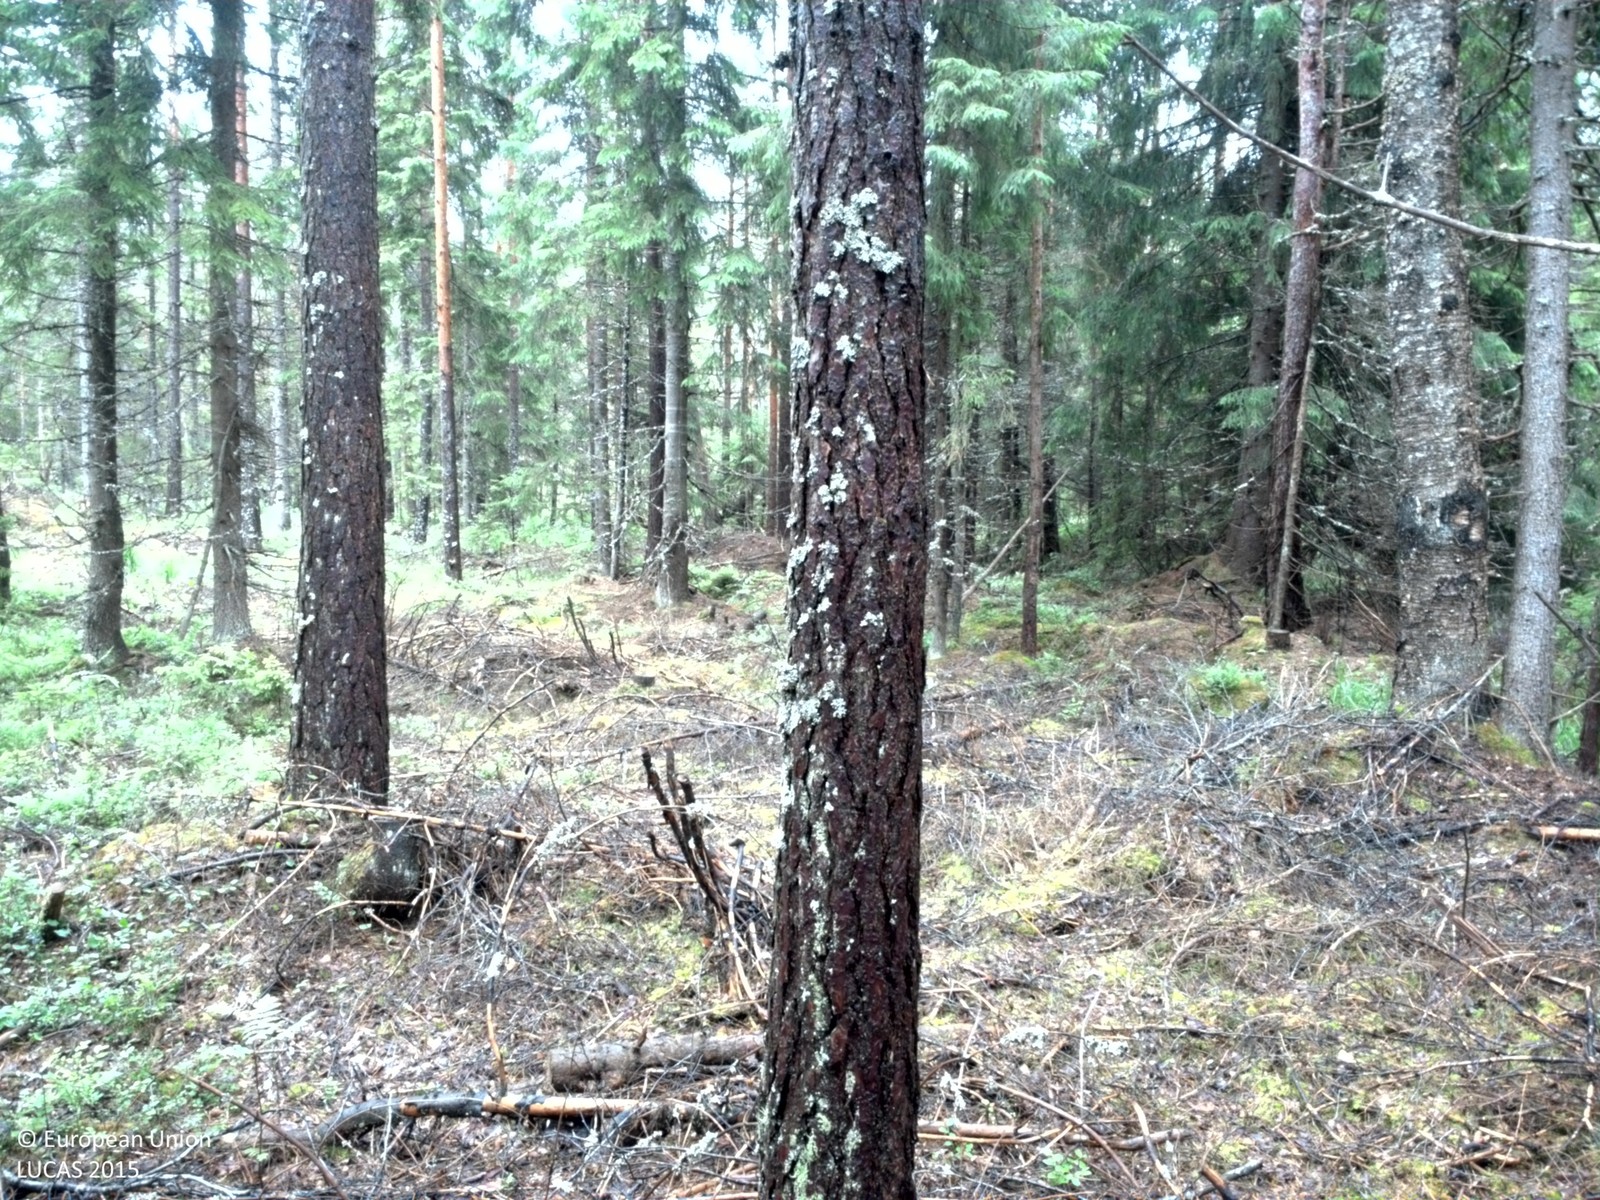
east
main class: Woodland
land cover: Spruce dominated coniferous woodland
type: boreal forest
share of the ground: 50 - 75 %
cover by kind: coniferous forest trees 55 %, shrubs 15 %, lichens and mosses 15 %, broadleaved forest trees 5 %, herbaceous plants 5 %
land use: Forestry
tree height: > 5 m
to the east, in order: Spruce dominated coniferous woodland; Tracks; Spruce dominated coniferous woodland; Ditches and canals; Other coniferous woodland; Tracks; Other coniferous woodland; Pine dominated coniferous woodland; Tracks; Spruce dominated coniferous woodland; Tracks; Other coniferous woodland
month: July
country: SE
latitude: 59.4903
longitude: 14.6706
